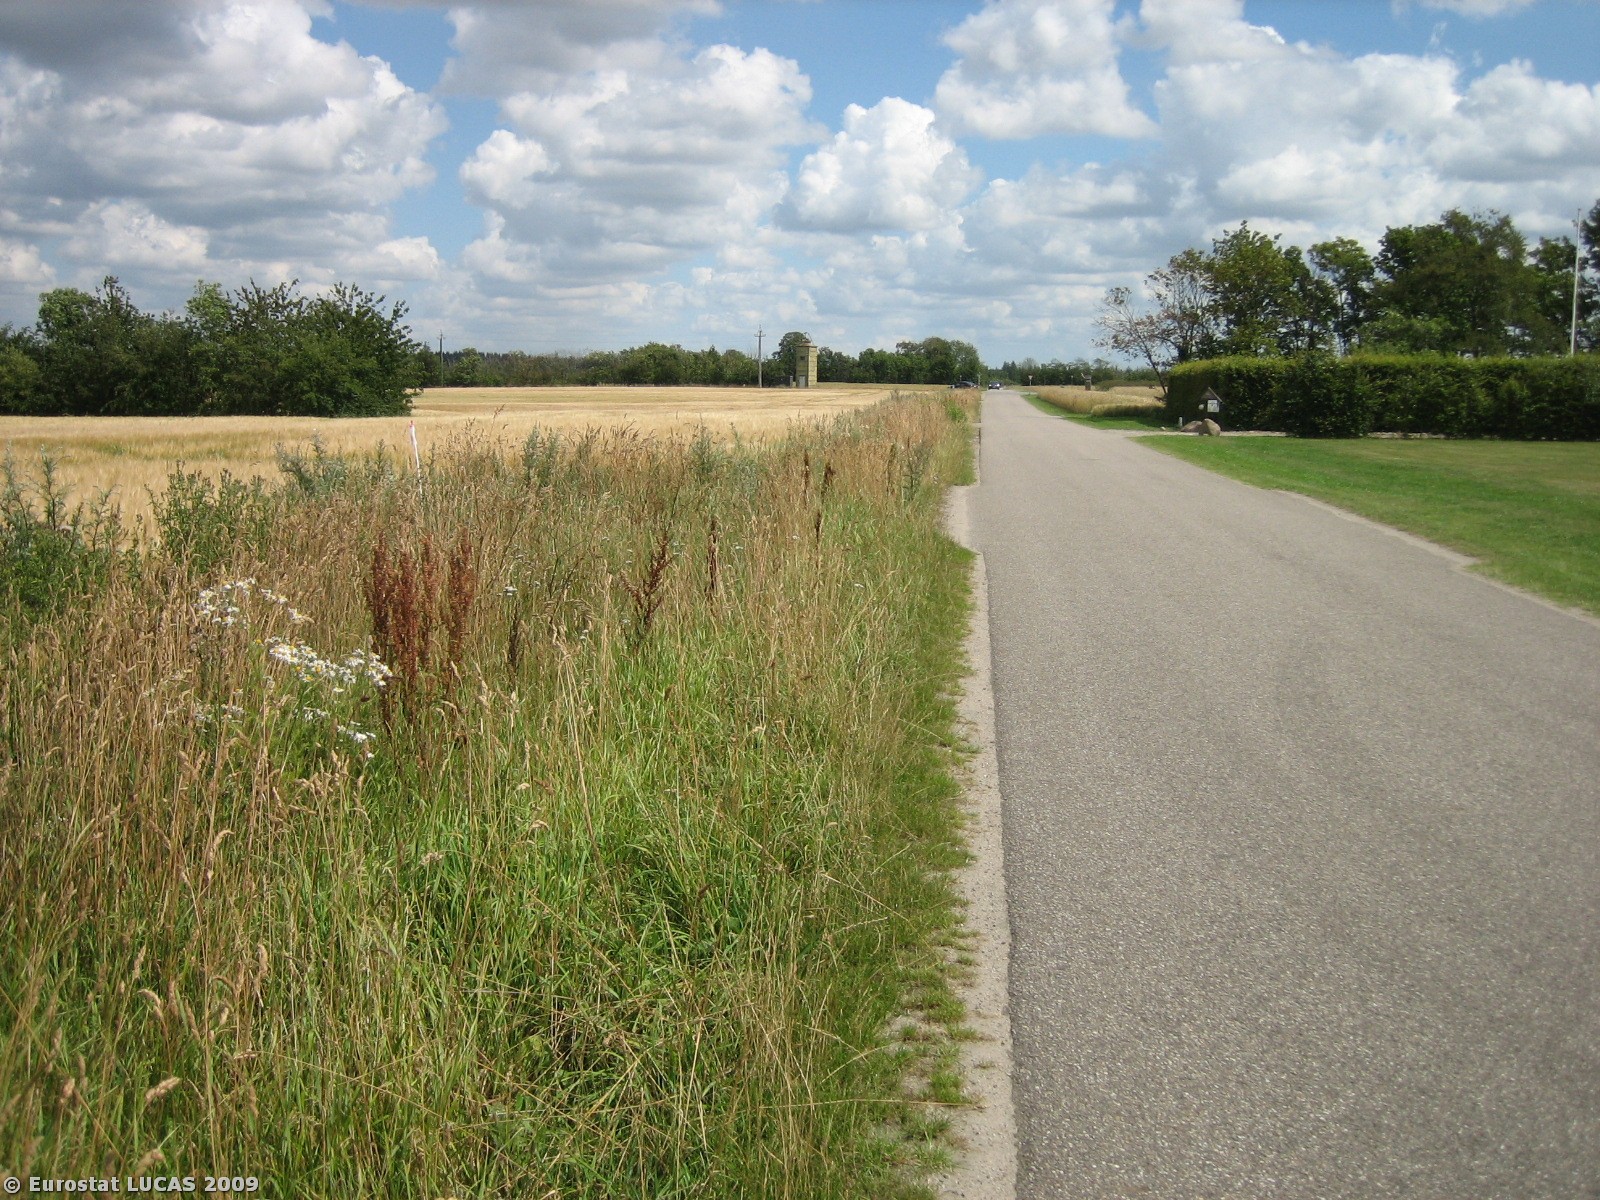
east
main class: Cropland
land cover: Barley
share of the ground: > 75 %
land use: Agriculture (excluding fallow land and kitchen gardens)
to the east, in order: Barley; Broadleaved woodland; Barley; Grass margins; Paved roads, cycling and walking lanes; Grass margins; Electric lines; Broadleaved woodland
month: July
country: DK
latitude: 55.7164
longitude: 8.9982
